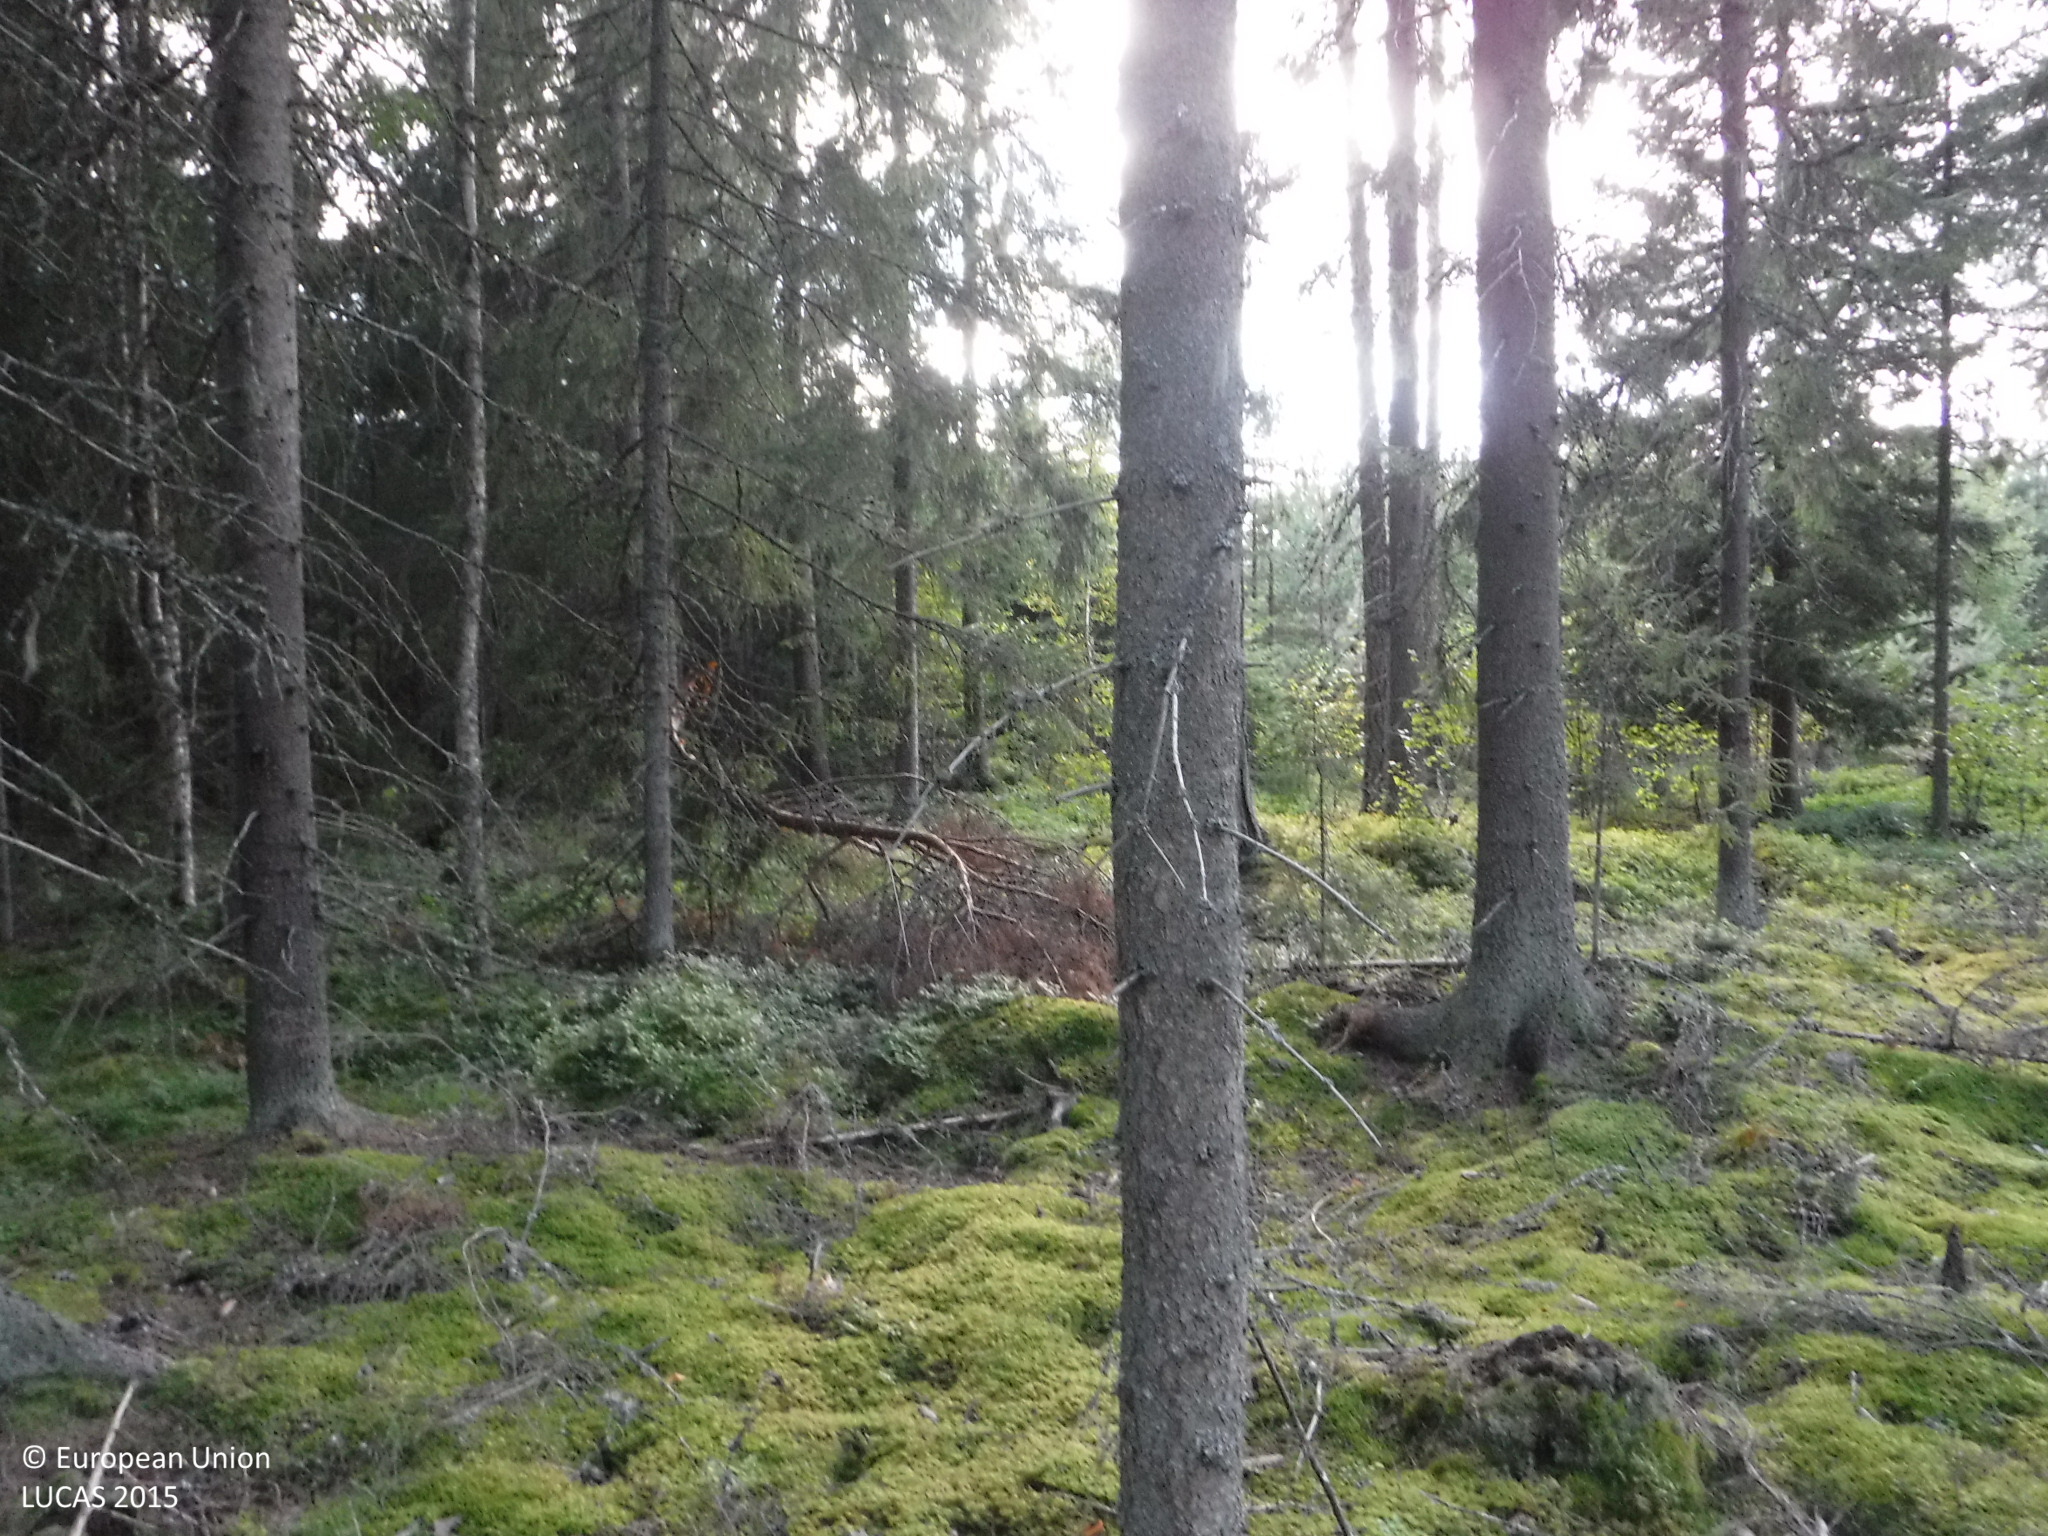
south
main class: Woodland
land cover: Spruce dominated coniferous woodland
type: boreal forest
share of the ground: 50 - 75 %
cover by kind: coniferous forest trees 50 %, shrubs 40 %, lichens and mosses 10 %
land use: Forestry
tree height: > 5 m
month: August
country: FI
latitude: 61.1885
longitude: 21.9064
